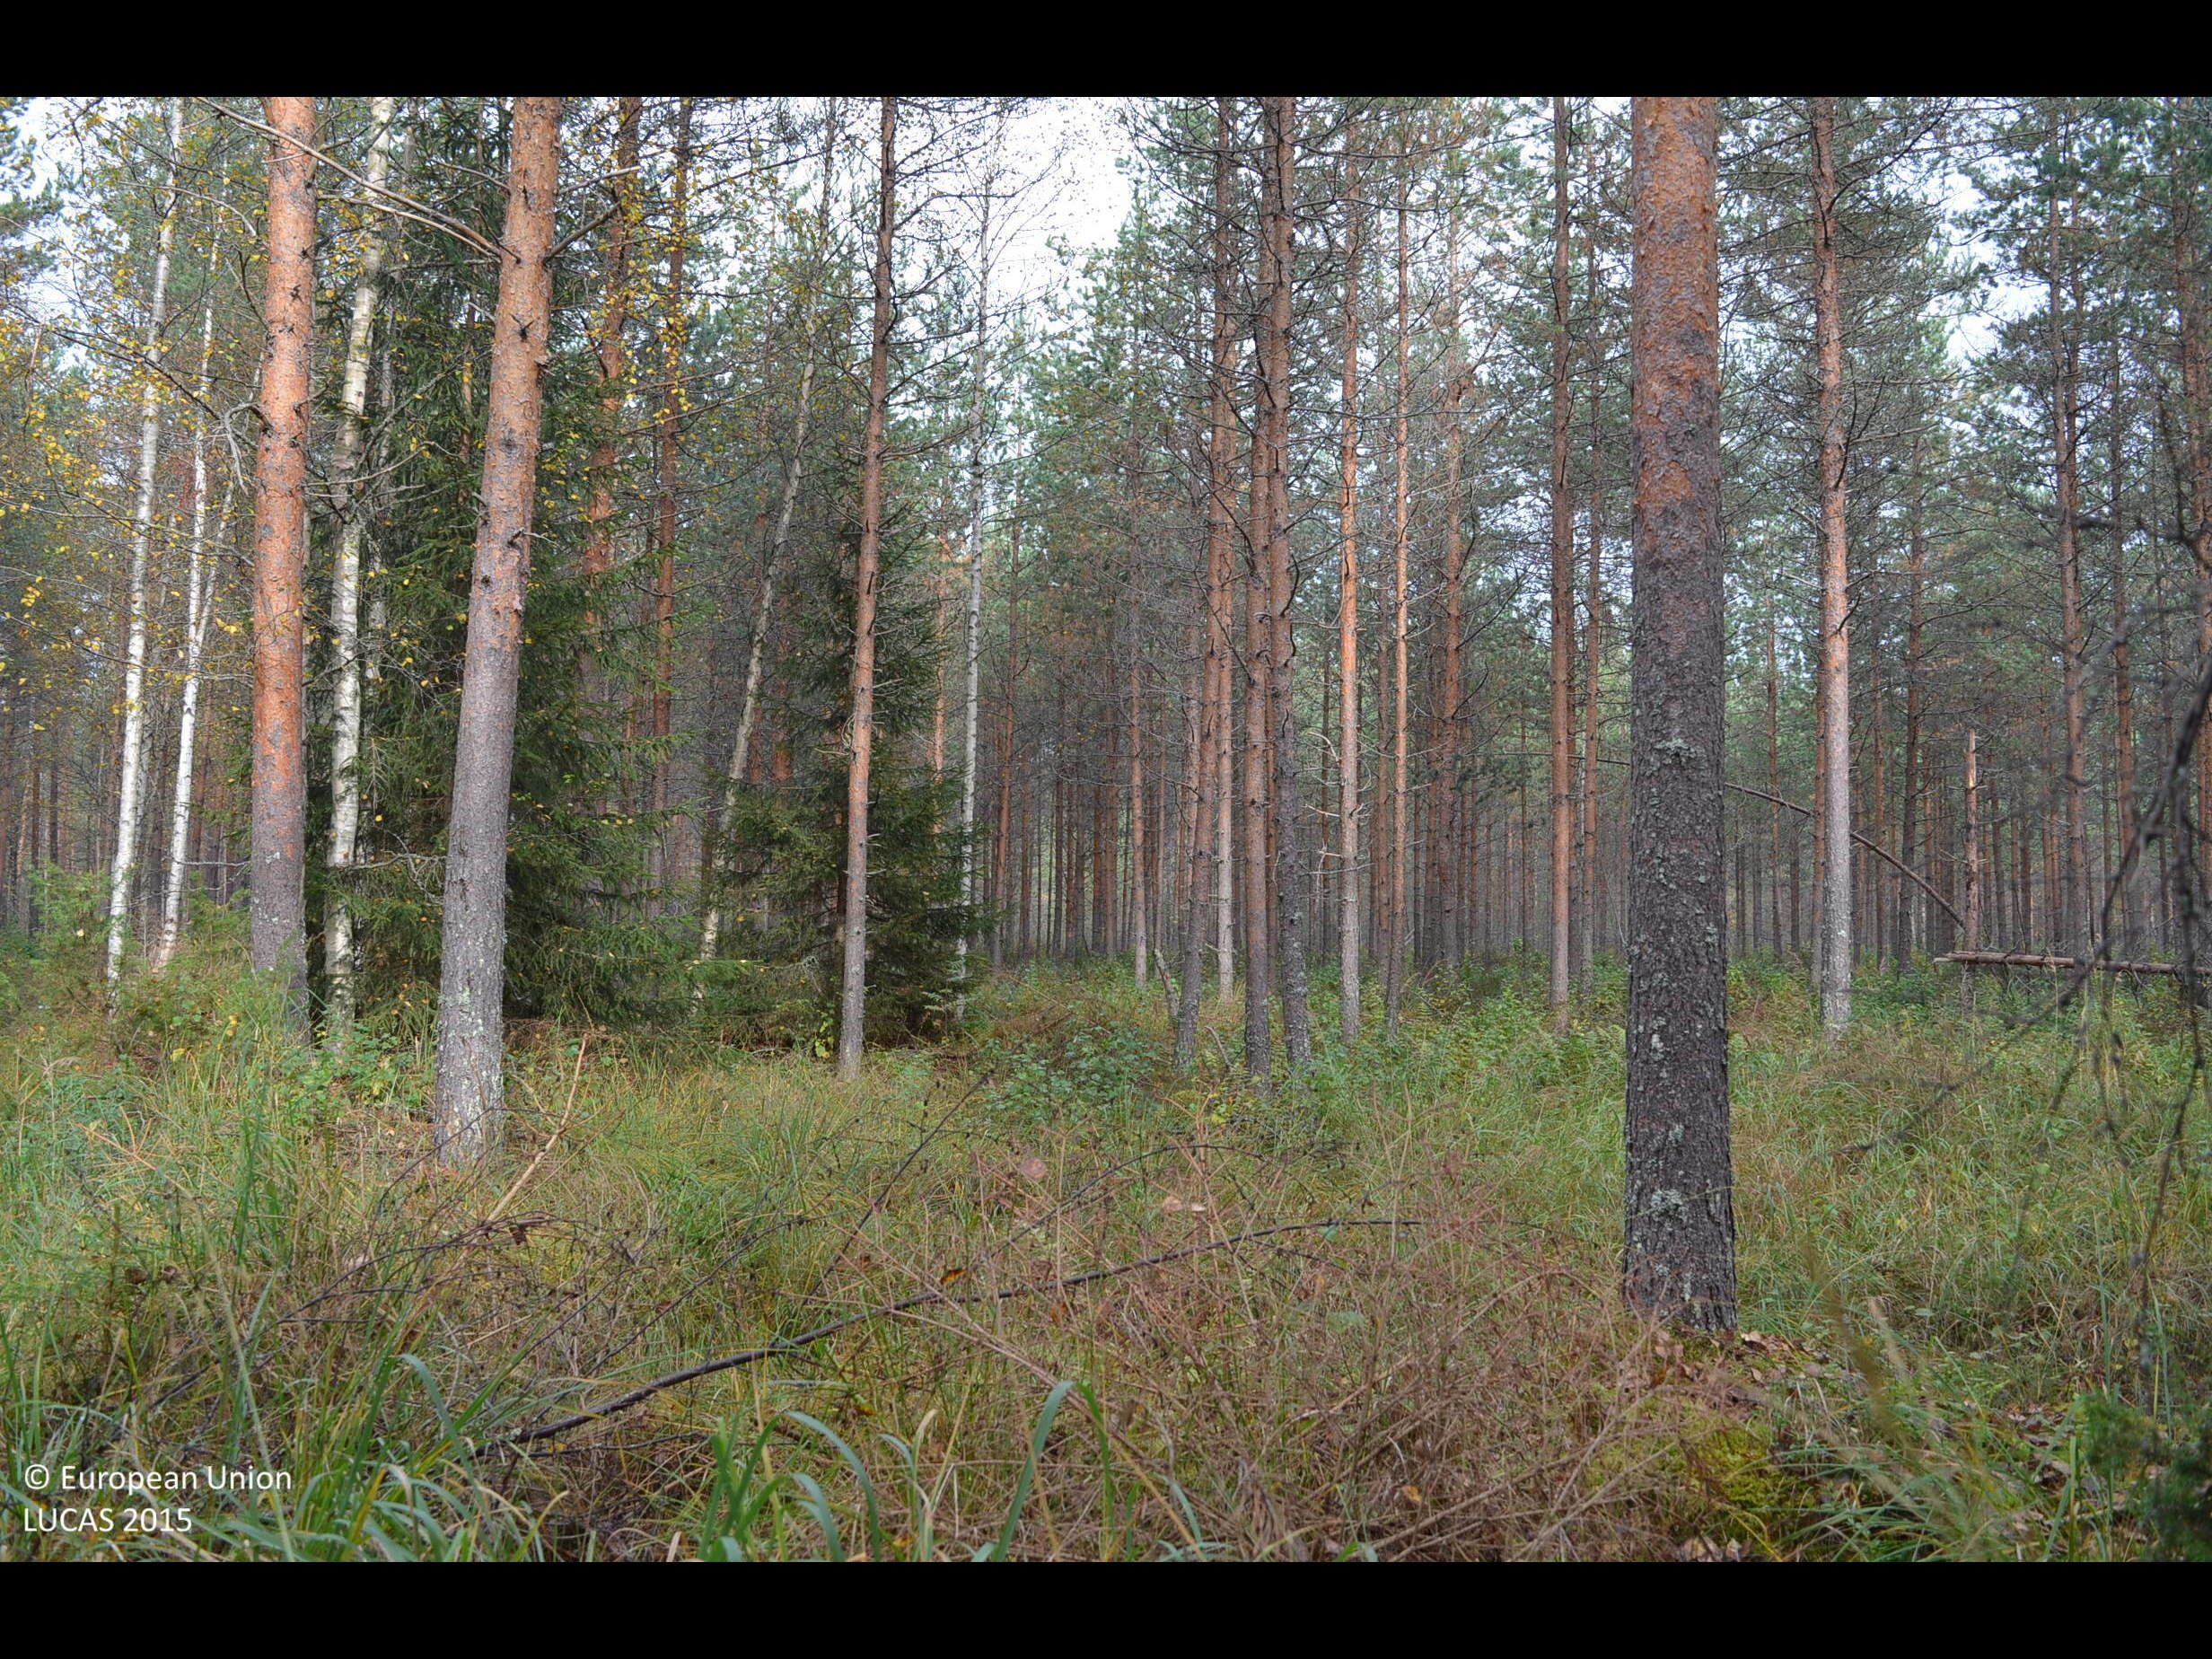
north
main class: Woodland
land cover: Pine dominated mixed woodland
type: boreal forest
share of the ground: > 75 %
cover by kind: coniferous forest trees 55 %, broadleaved forest trees 20 %, herbaceous plants 15 %, shrubs 10 %
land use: Forestry
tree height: > 5 m
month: September
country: FI
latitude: 62.6951
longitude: 23.7320
